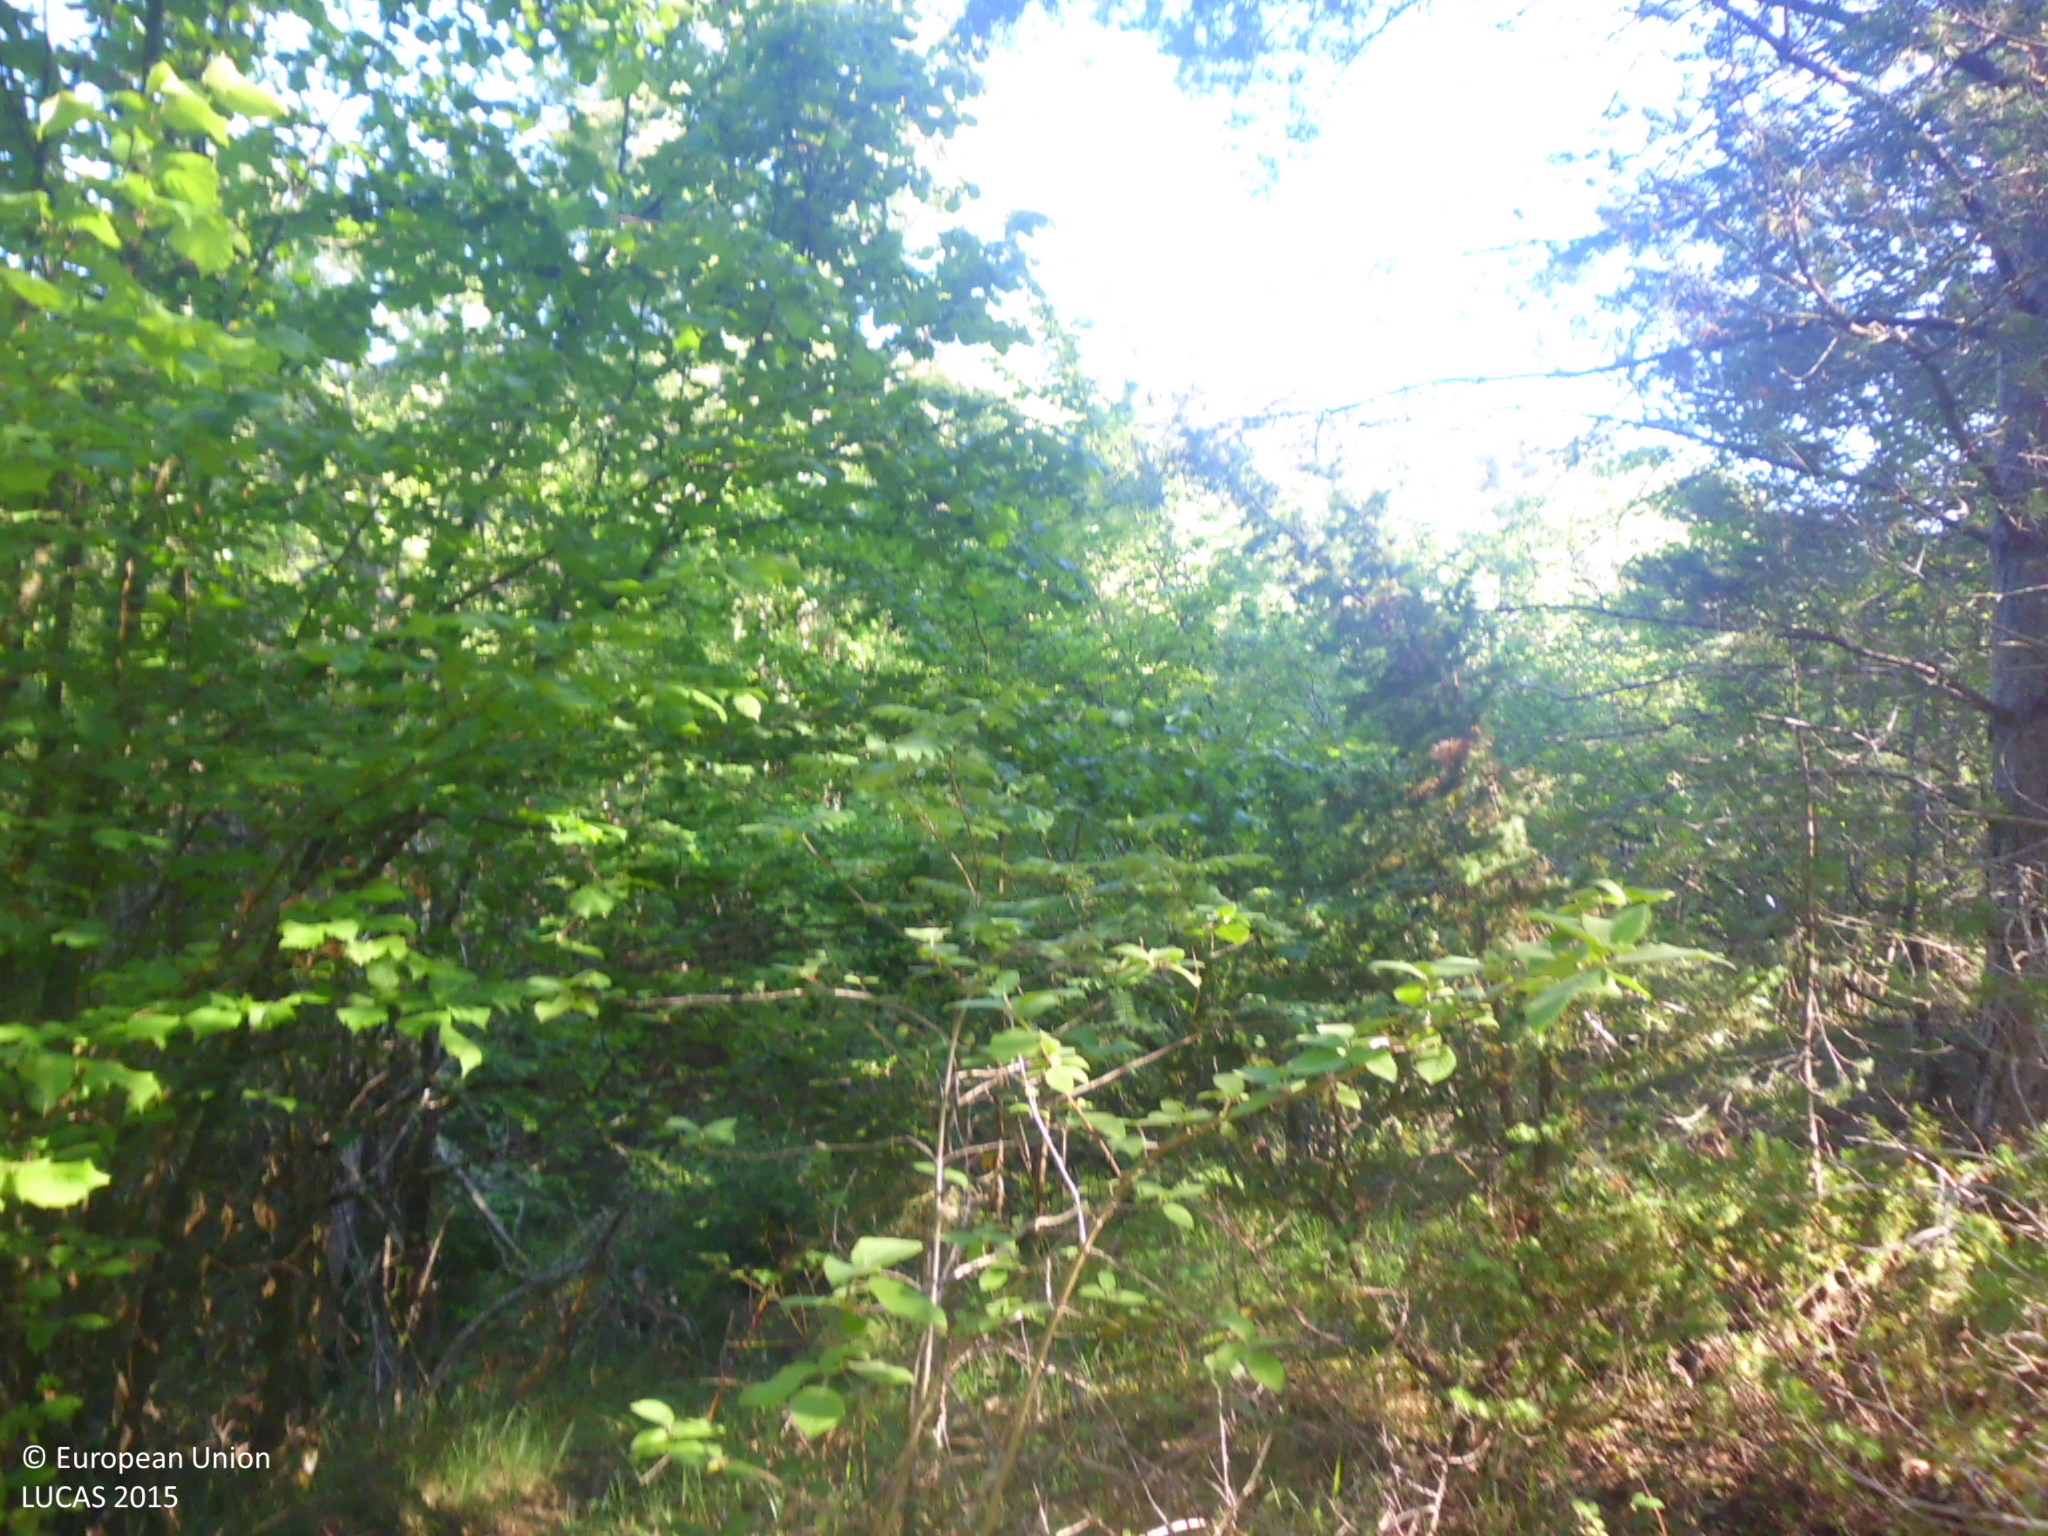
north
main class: Woodland
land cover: Pine dominated mixed woodland
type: coniferous forest of the mediterranean region
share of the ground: 50 - 75 %
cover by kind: coniferous forest trees 40 %, broadleaved forest trees 25 %, herbaceous plants 20 %, shrubs 15 %
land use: Forestry
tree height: > 5 m
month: June
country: ES
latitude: 42.8991
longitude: -3.3488
